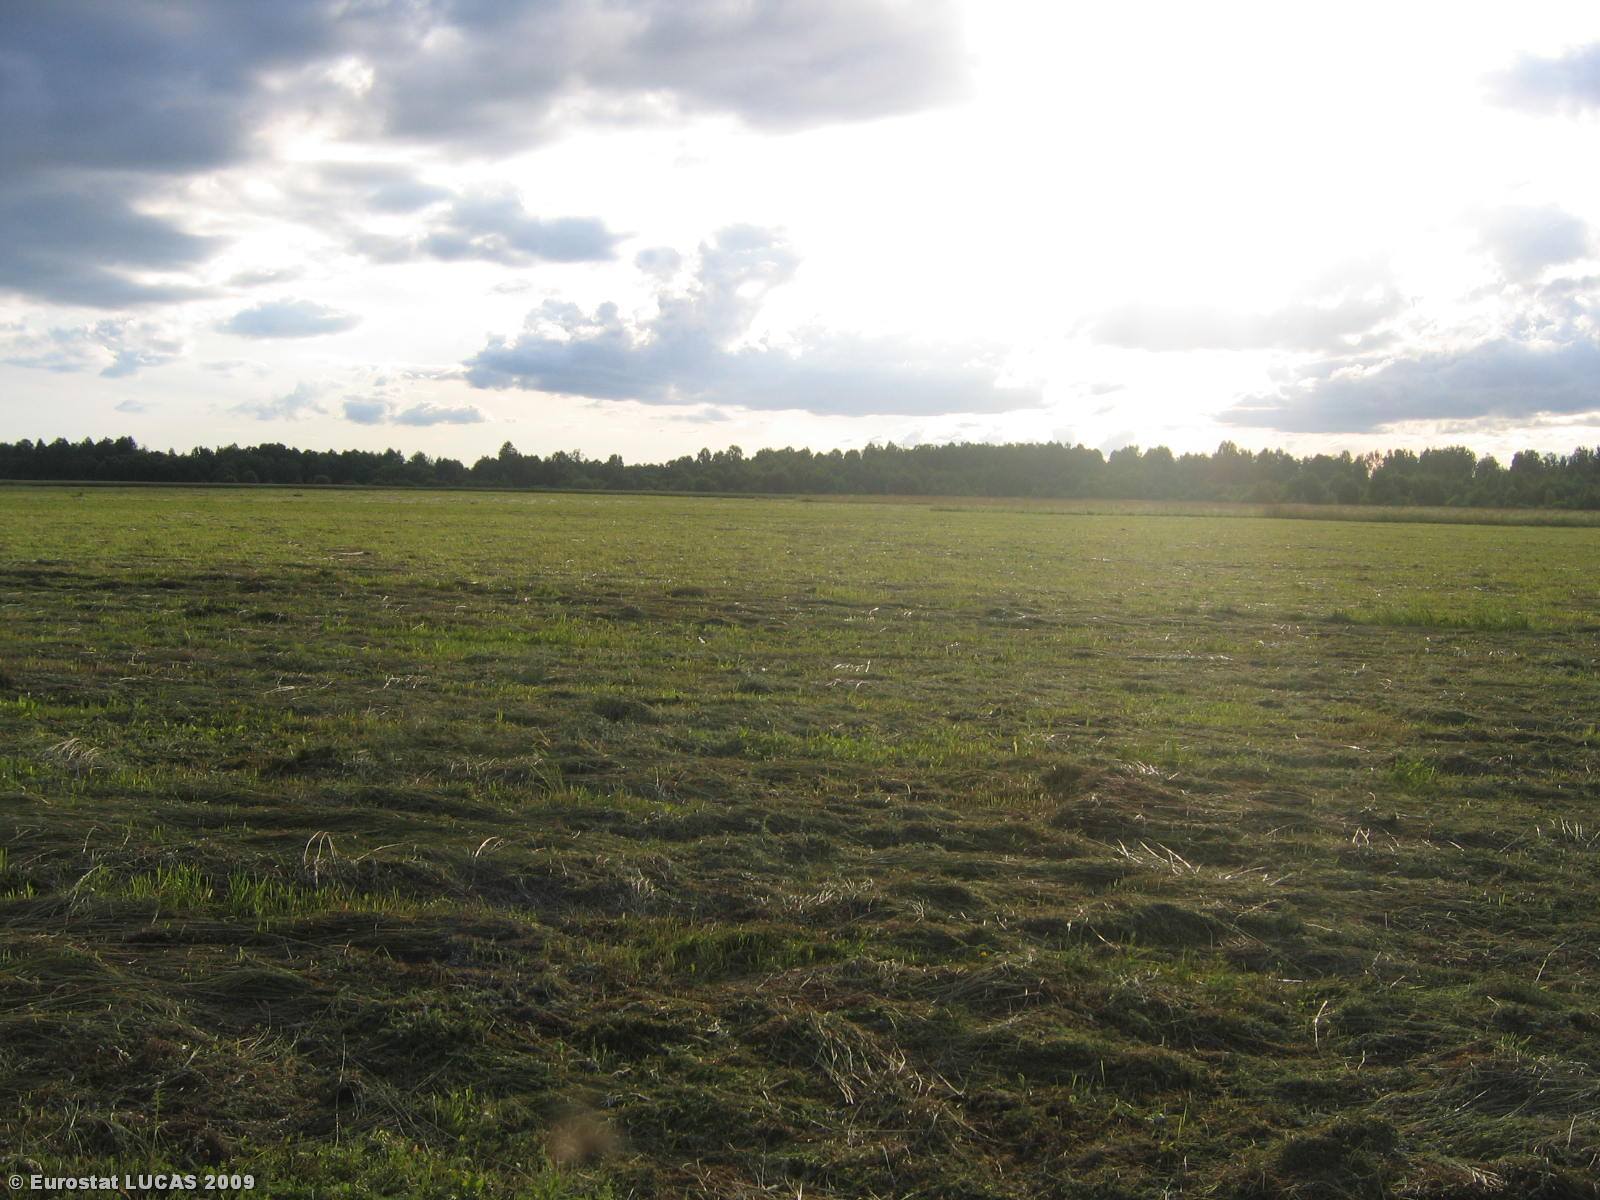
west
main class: Grassland
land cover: Grassland without tree/shrub cover
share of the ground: > 75 %
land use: Agriculture (excluding fallow land and kitchen gardens)
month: July
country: LT
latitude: 55.4030
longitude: 22.7463
